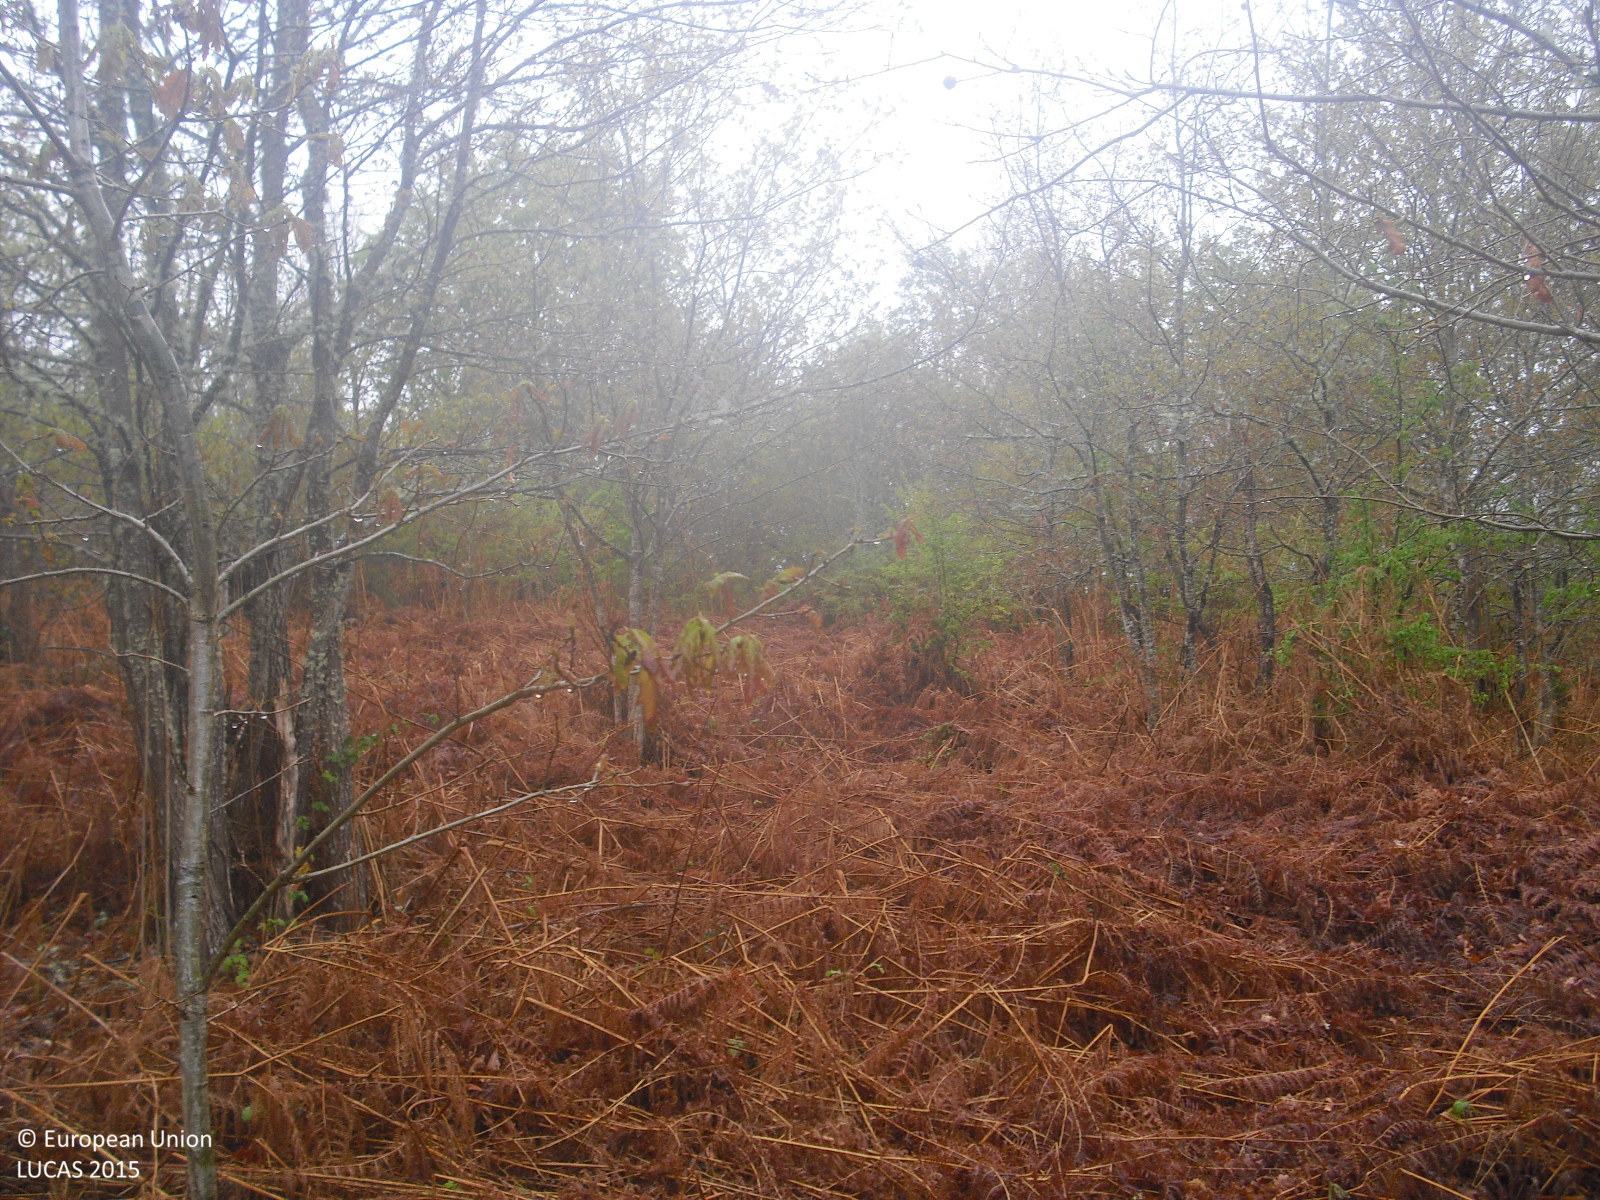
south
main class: Woodland
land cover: Broadleaved woodland
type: thermophilous deciduous forest
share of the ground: 50 - 75 %
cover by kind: shrubs 50 %, broadleaved forest trees 40 %, herbaceous plants 10 %
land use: Forestry
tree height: < 5 m
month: April
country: ES
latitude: 42.1118
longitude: -7.9140
